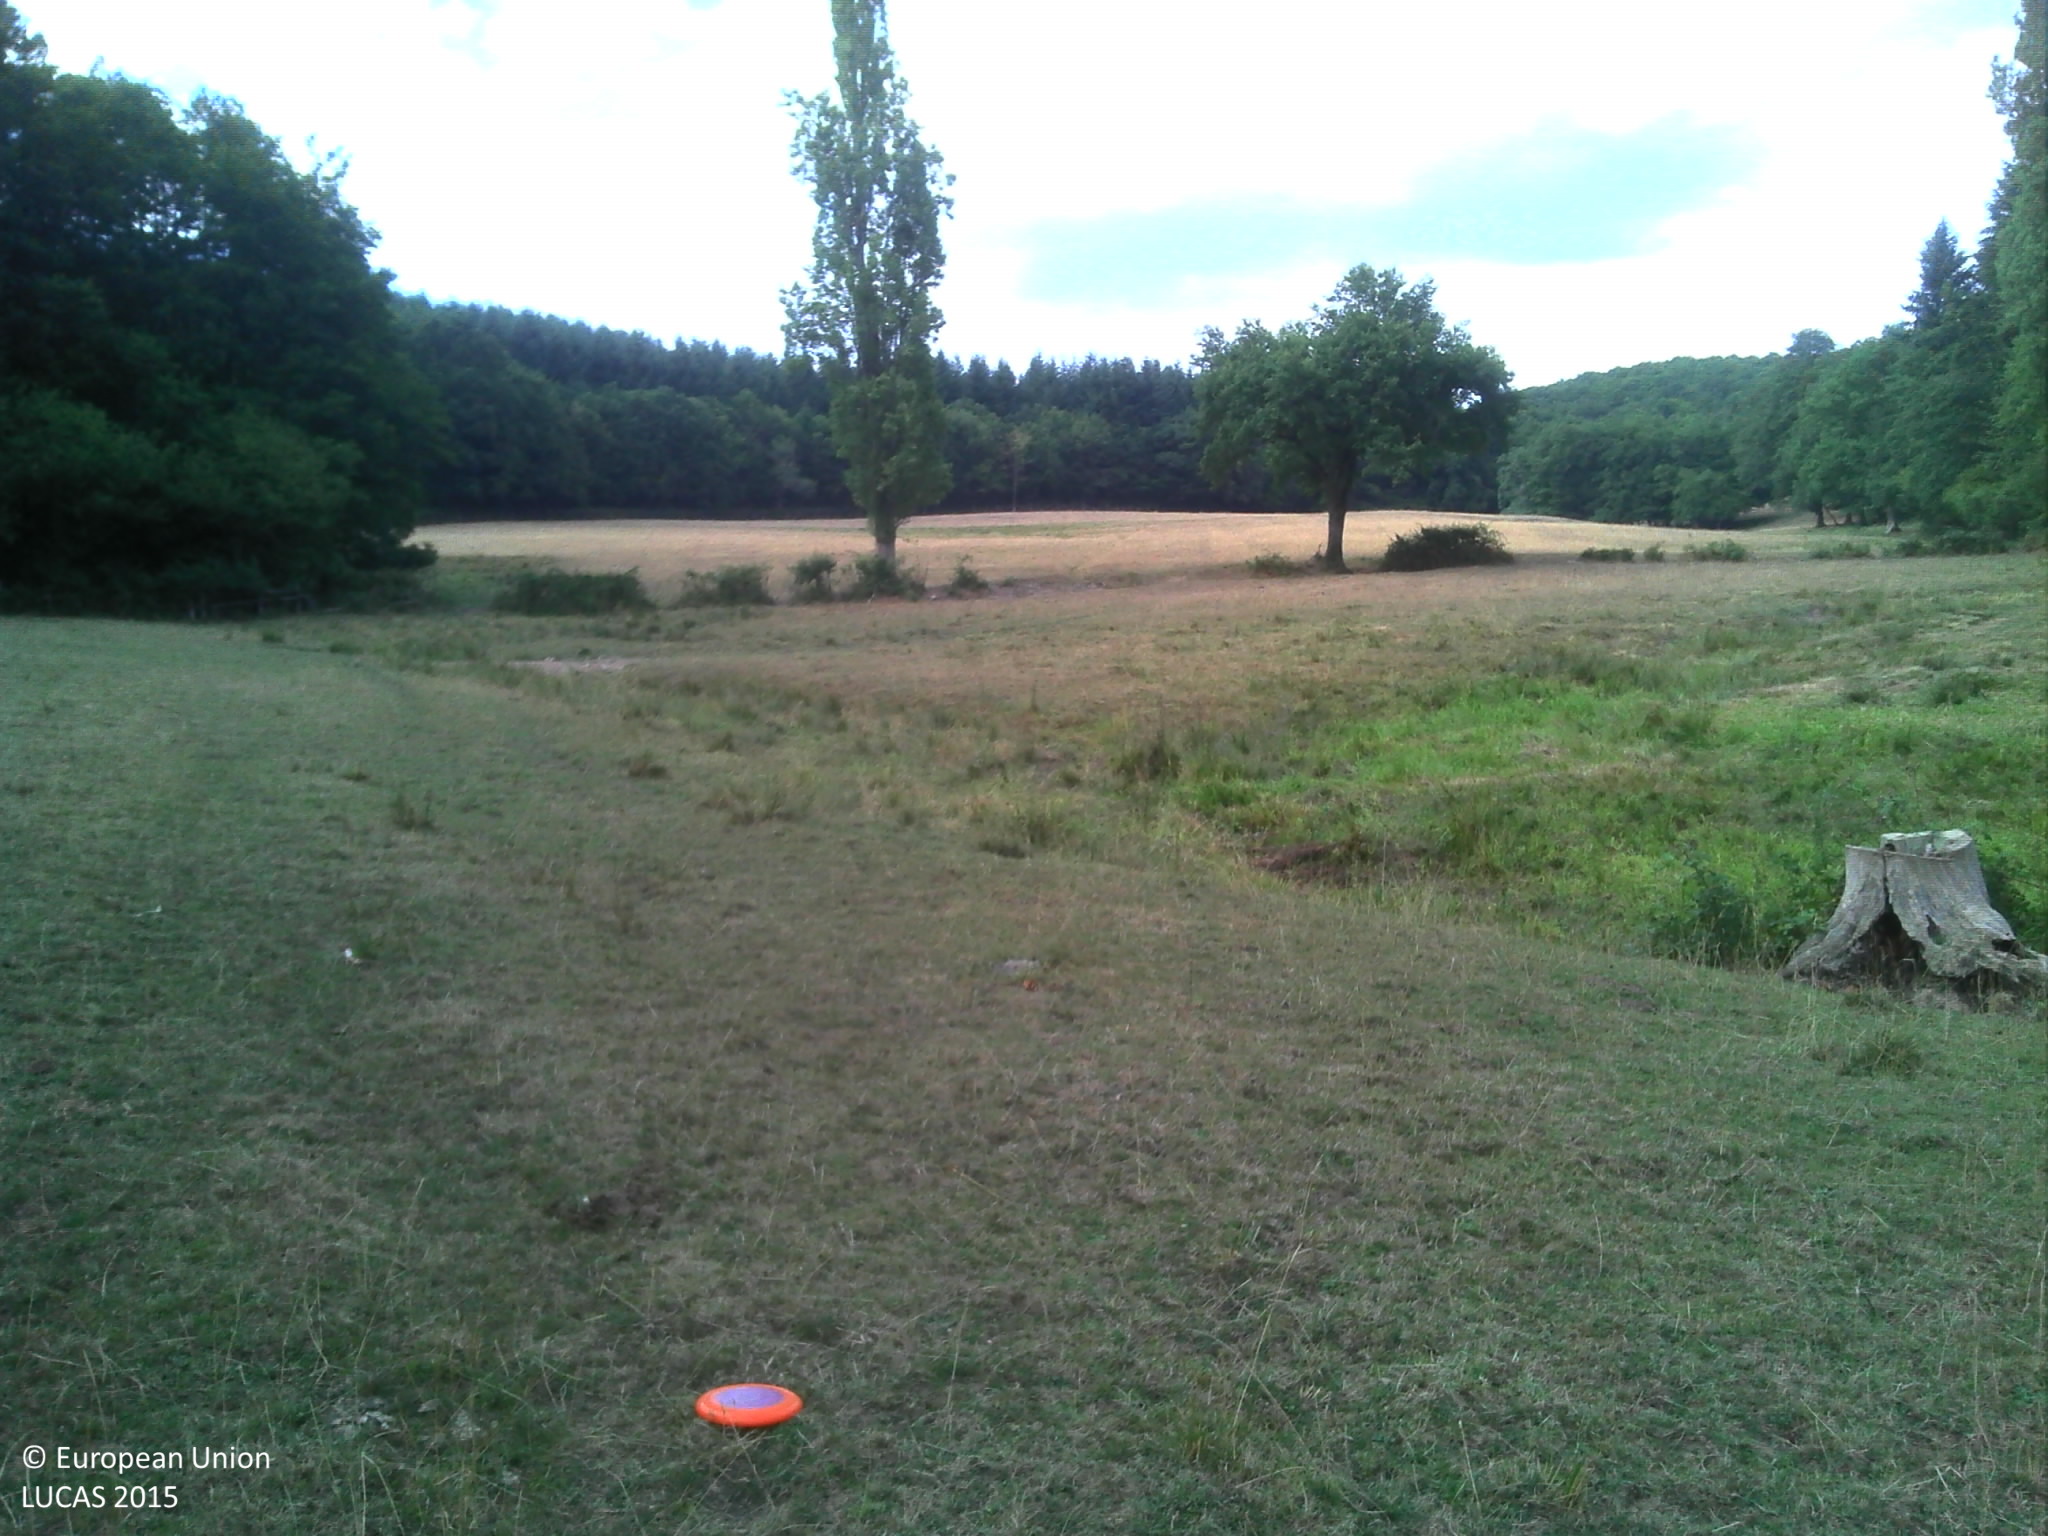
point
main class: Grassland
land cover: Grassland without tree/shrub cover
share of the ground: > 75 %
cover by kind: herbaceous plants 100 %
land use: Agriculture (excluding fallow land and kitchen gardens)
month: August
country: FR
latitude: 46.6582
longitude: 4.4469
